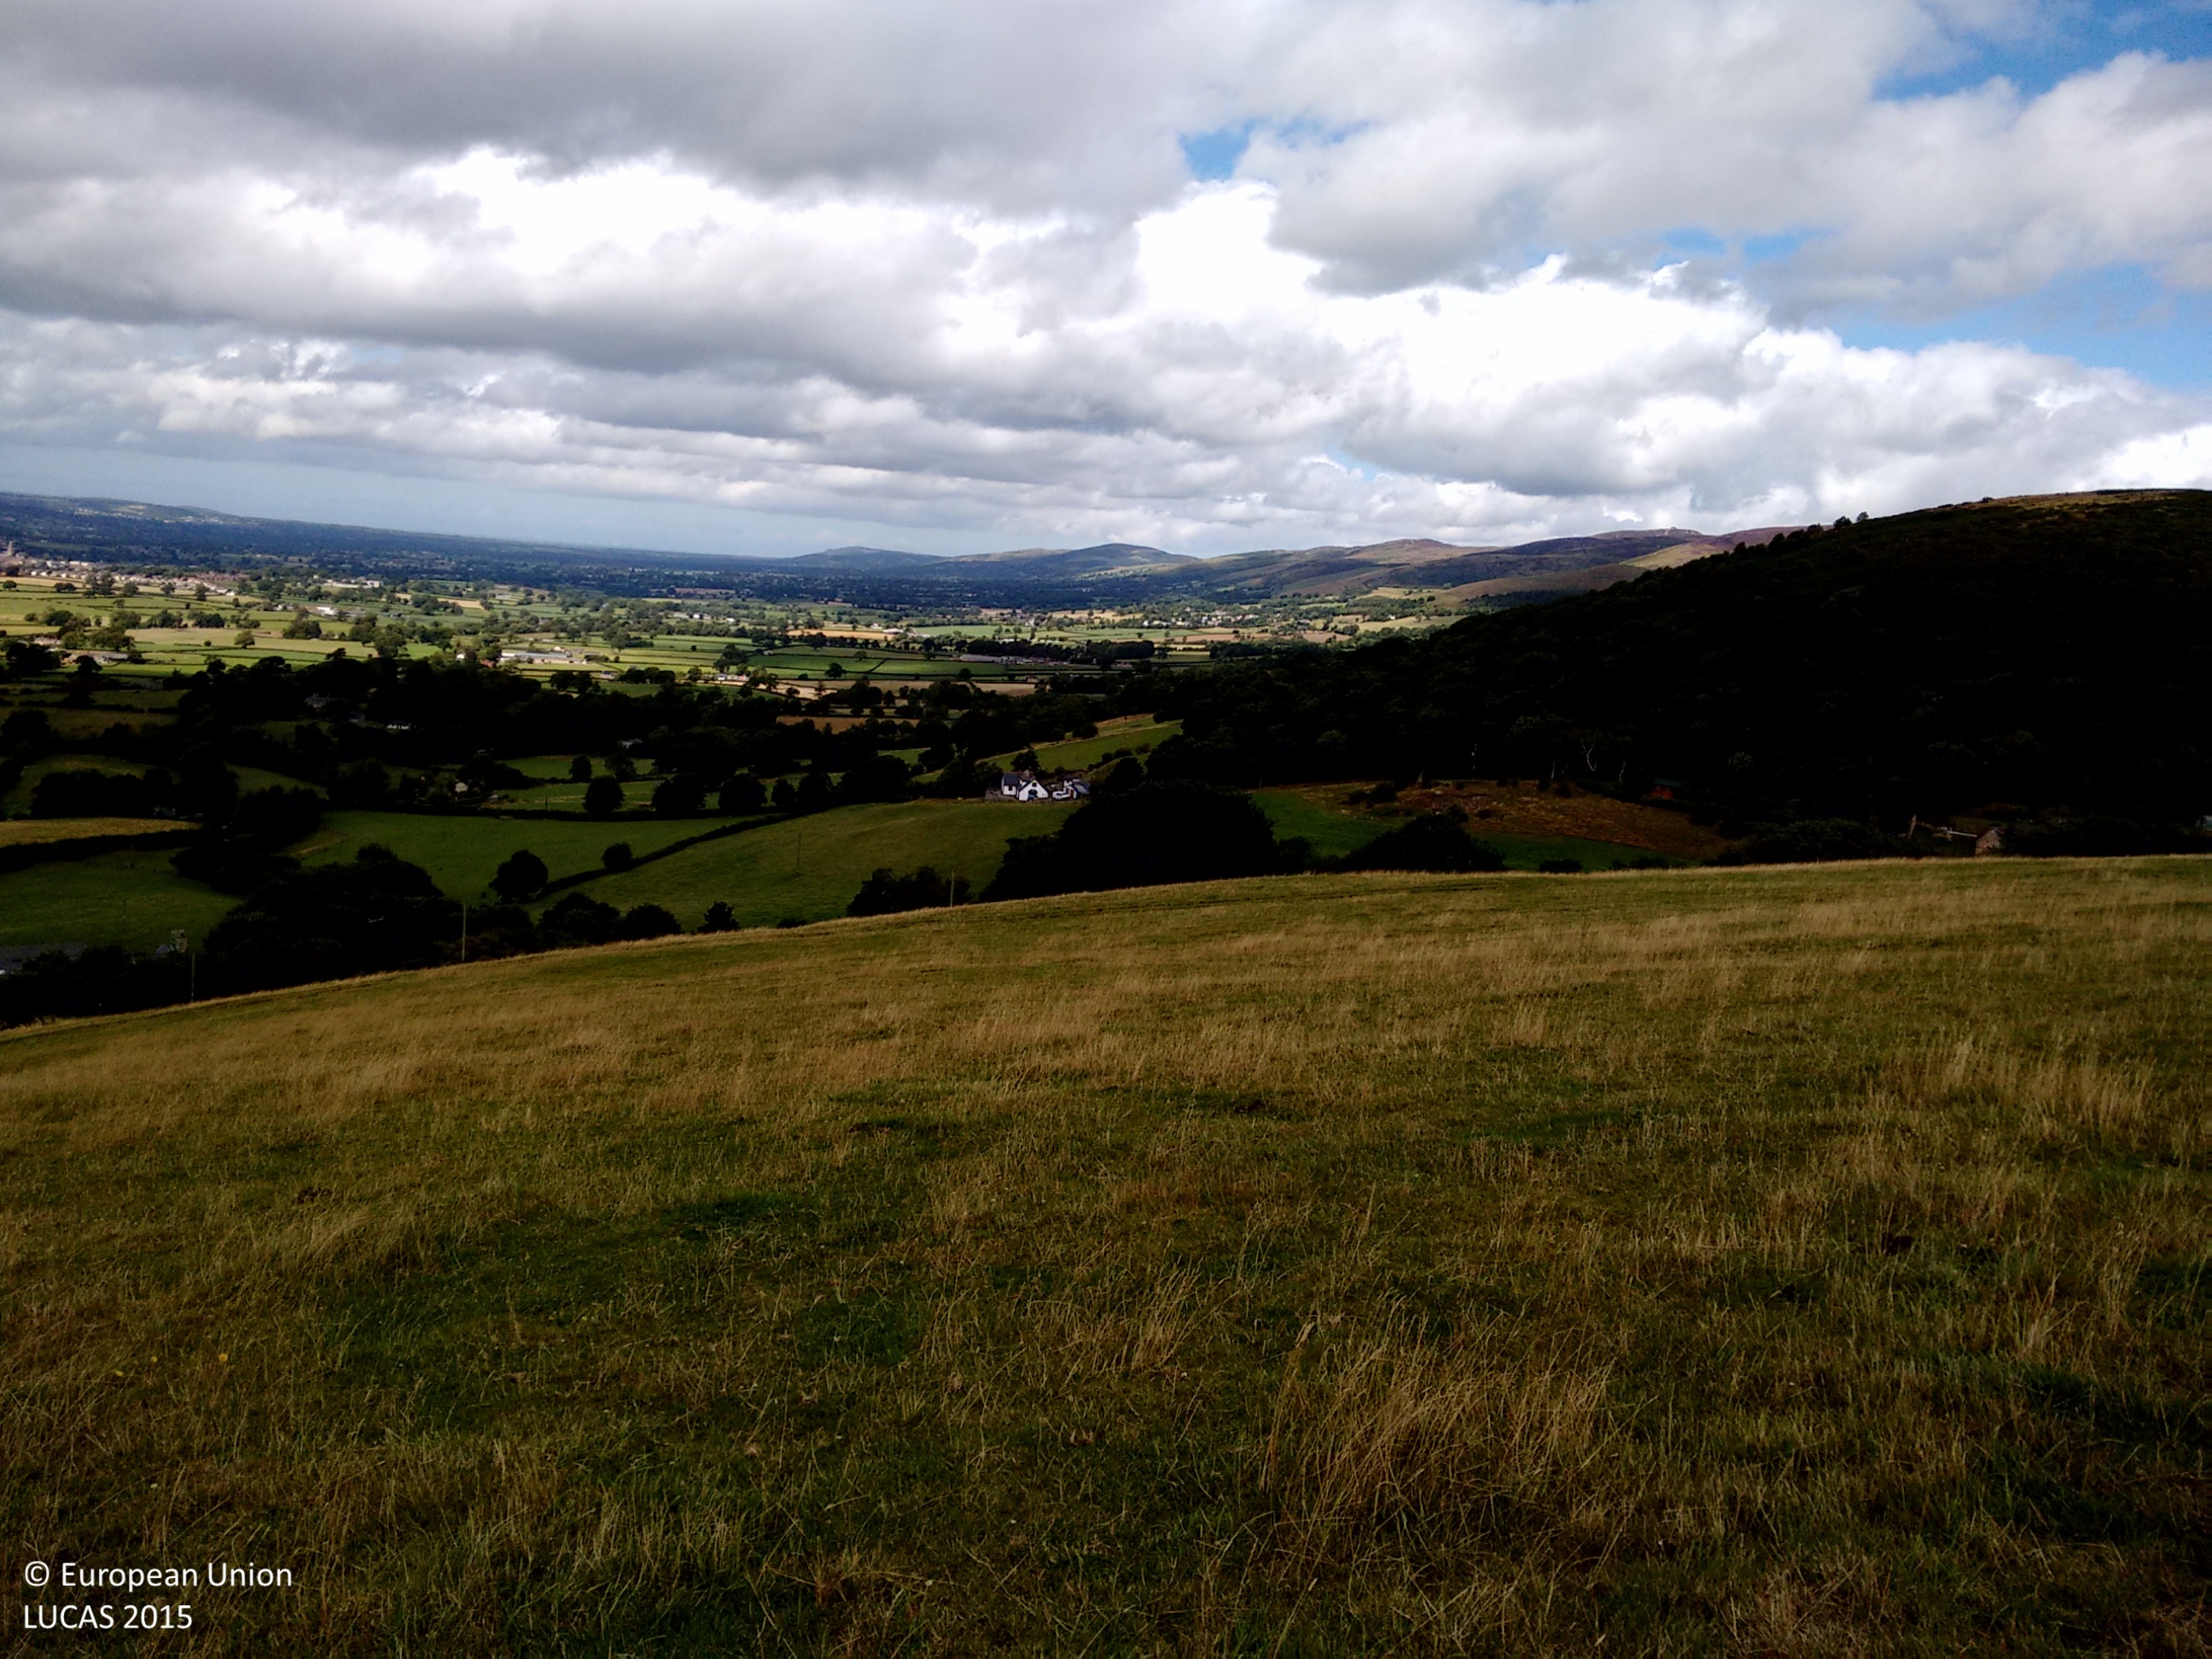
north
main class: Grassland
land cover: Grassland without tree/shrub cover
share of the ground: > 75 %
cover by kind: herbaceous plants 100 %
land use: Agriculture (excluding fallow land and kitchen gardens)
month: August
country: GB
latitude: 53.0875
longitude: -3.2634
